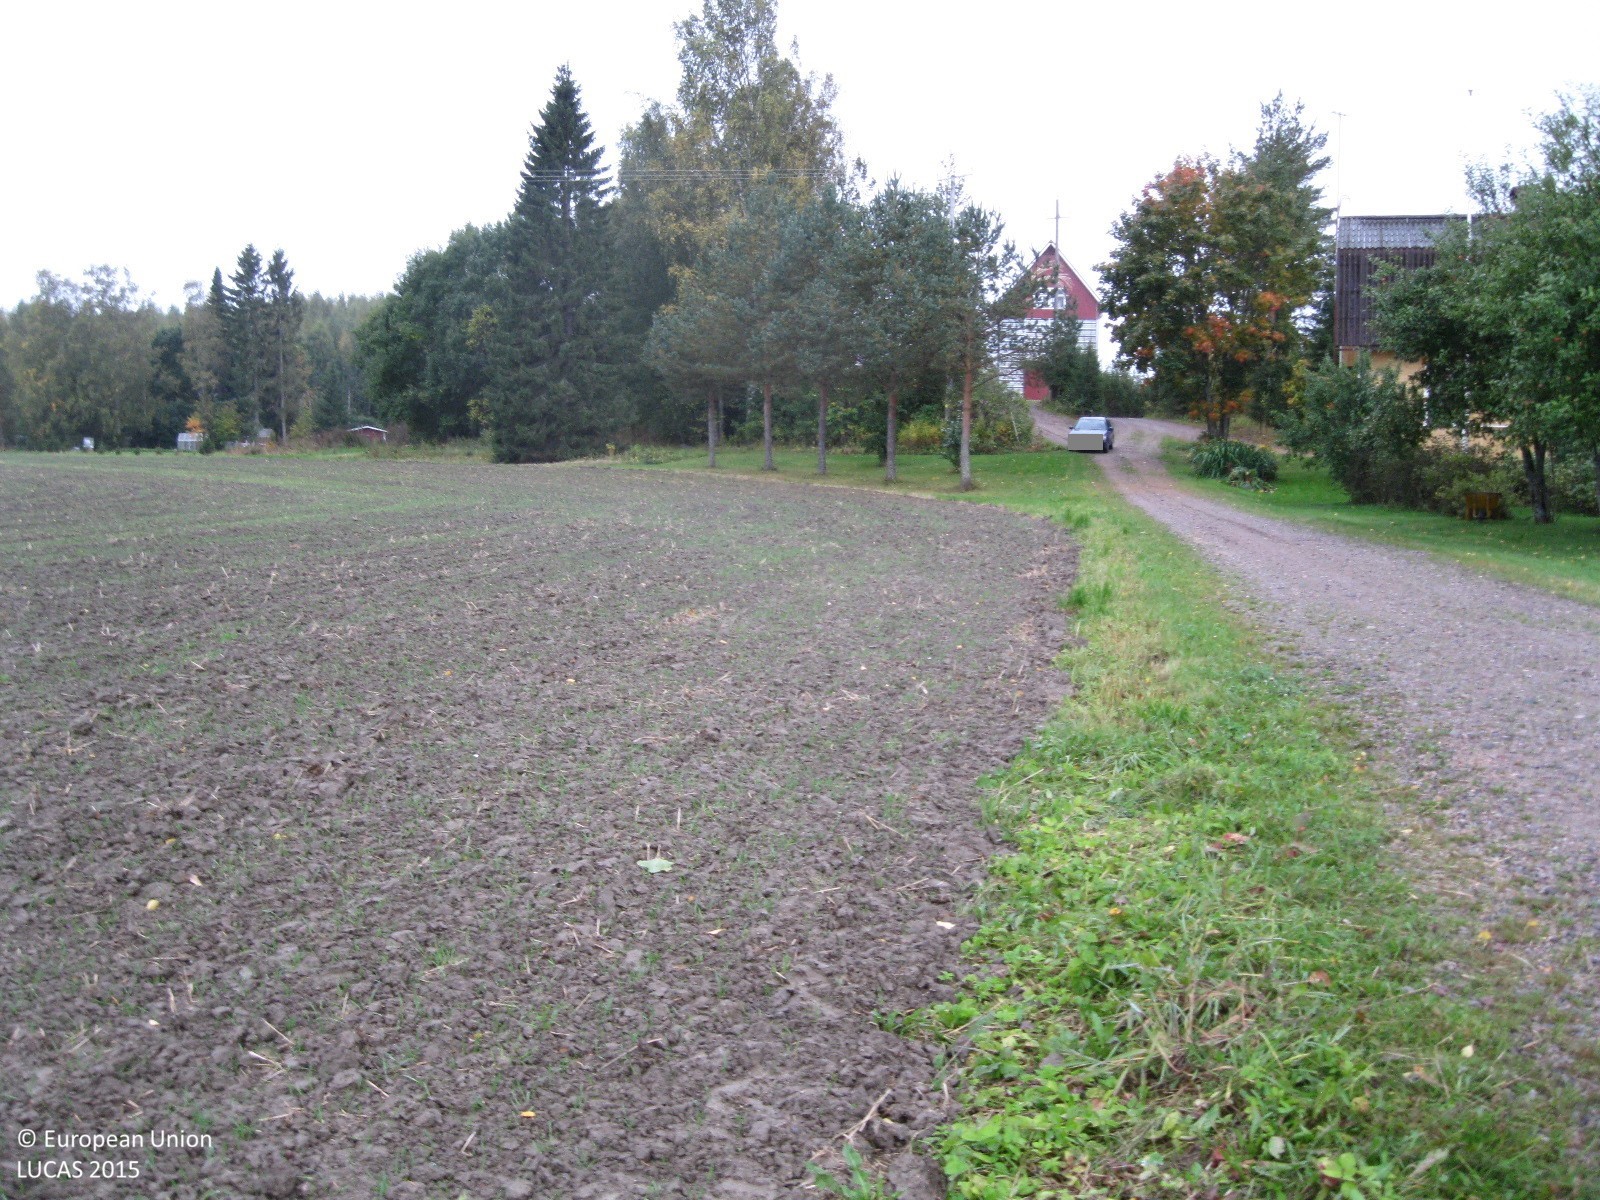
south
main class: Cropland
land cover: Common wheat
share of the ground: < 10 %
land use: Agriculture (excluding fallow land and kitchen gardens)
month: September
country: FI
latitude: 60.8160
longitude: 24.7246
